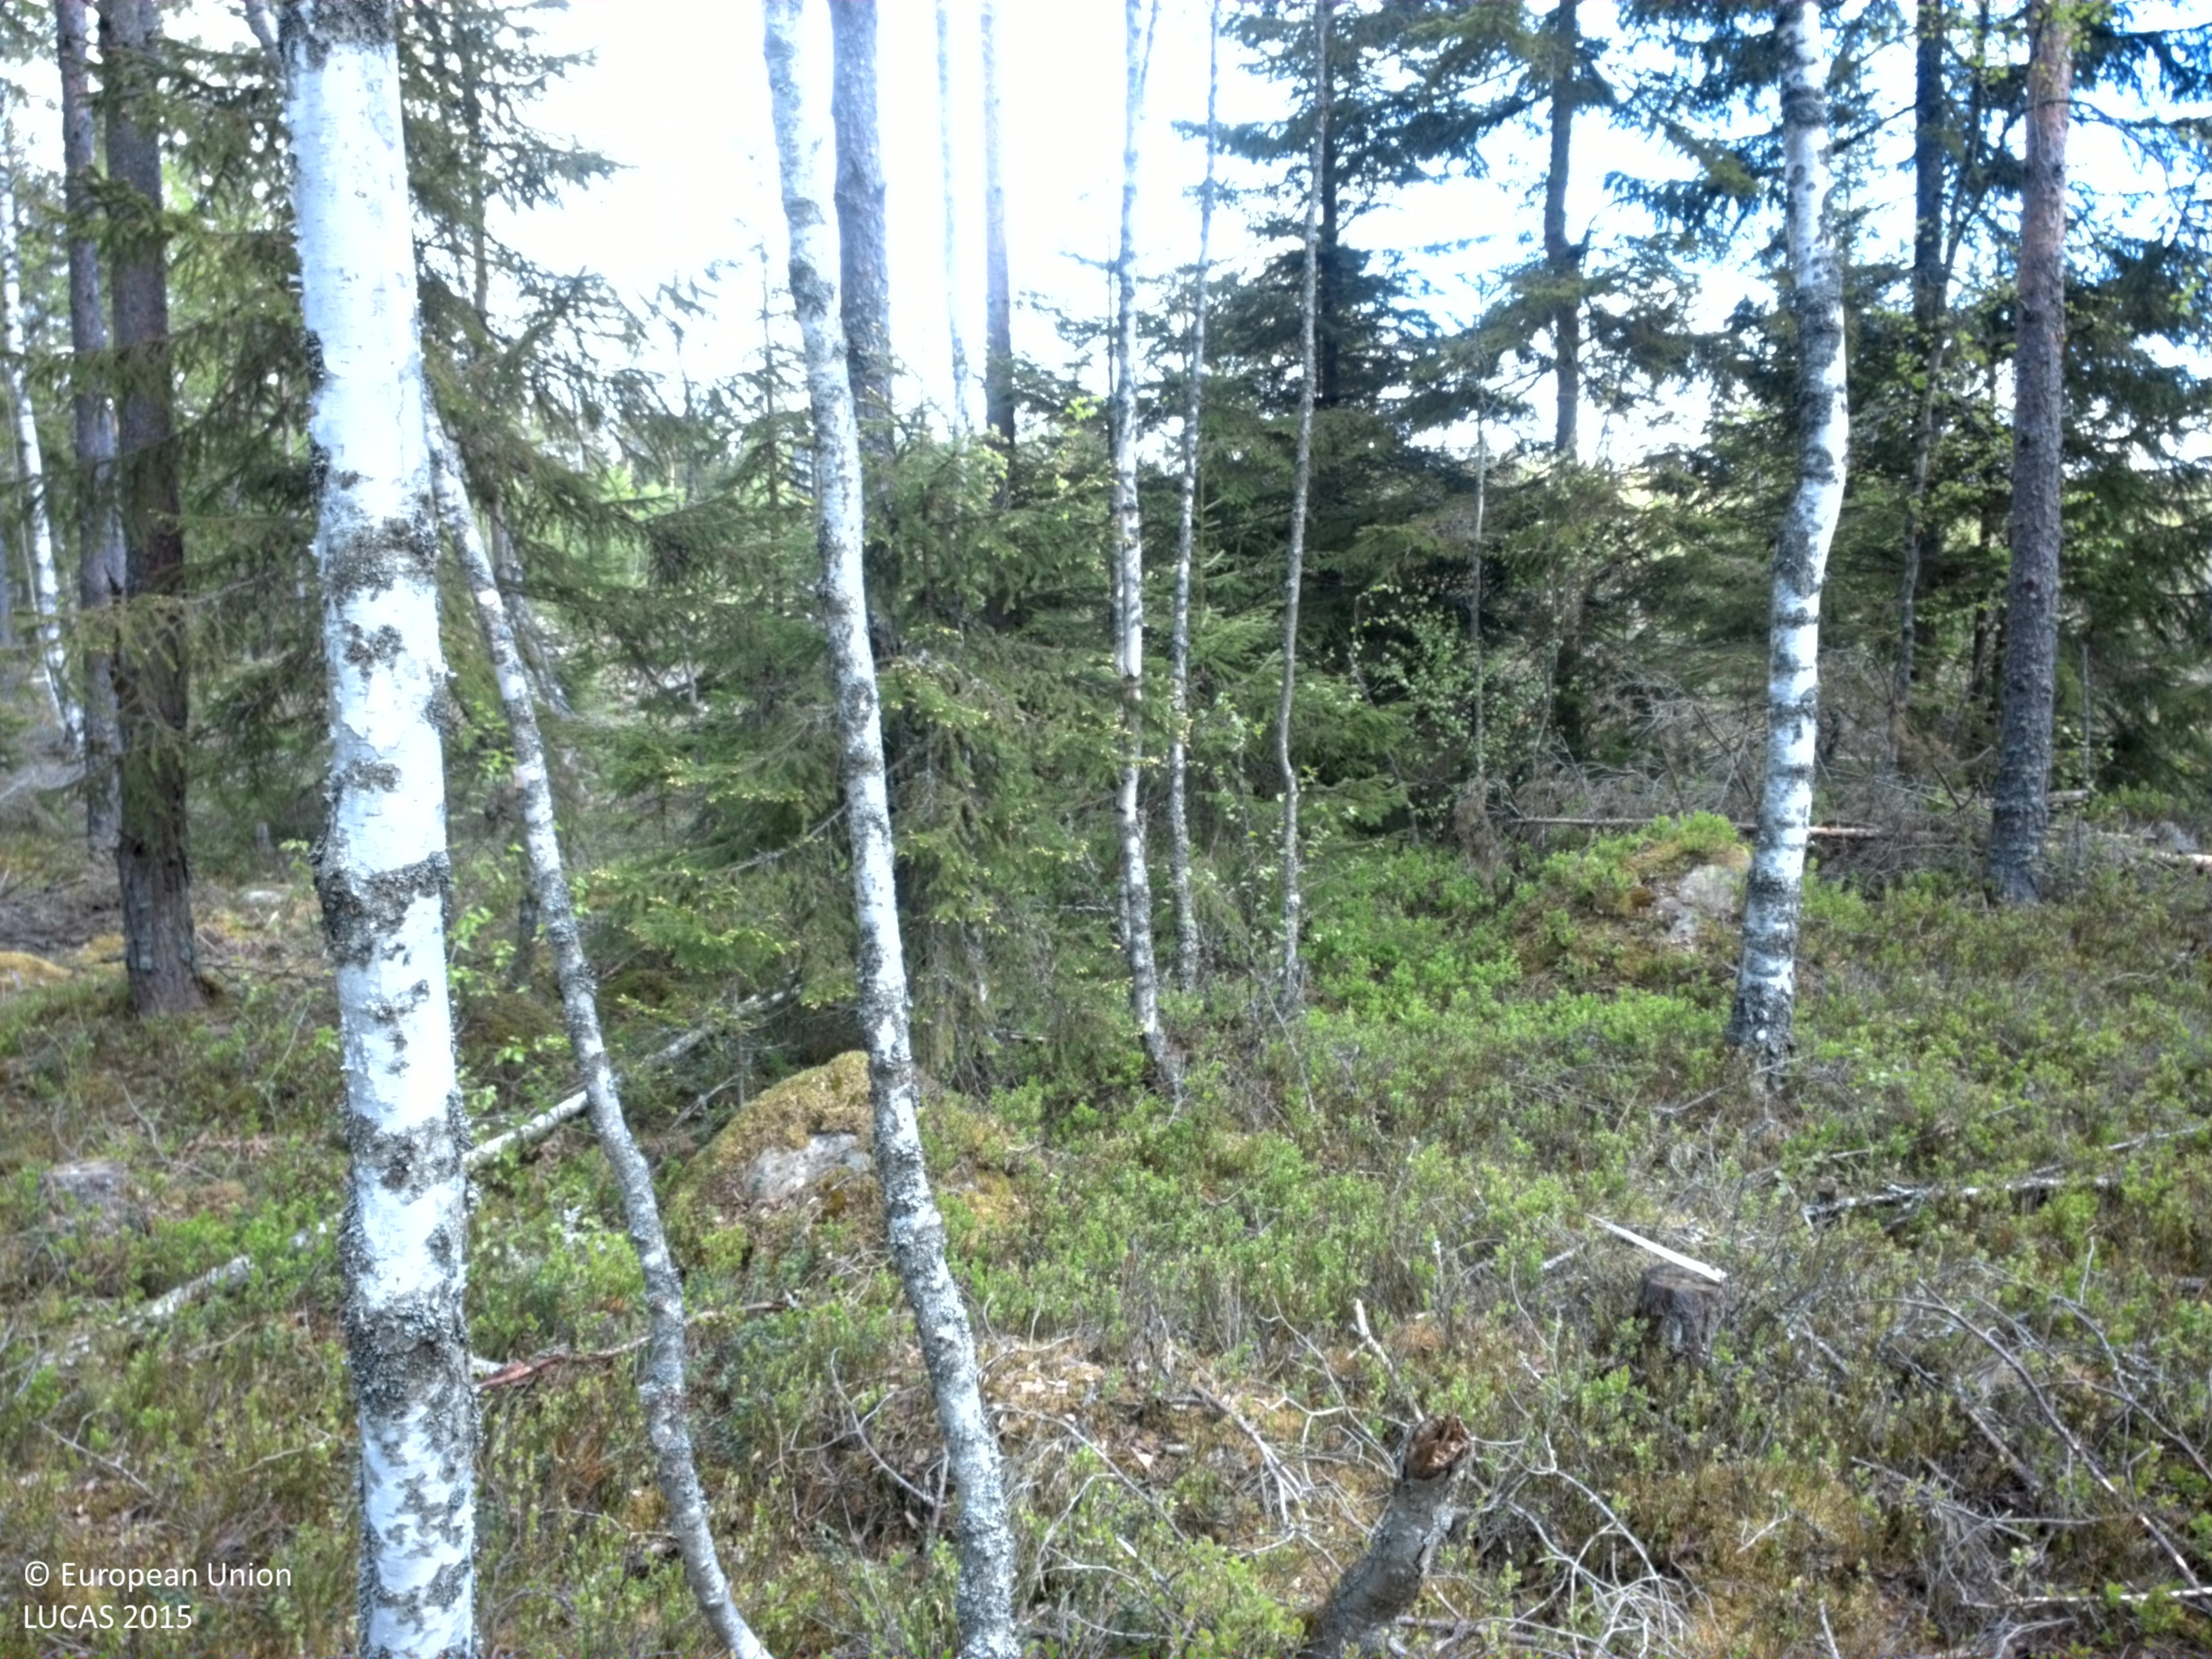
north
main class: Woodland
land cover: Pine dominated coniferous woodland
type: boreal forest
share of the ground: 25 - 50 %
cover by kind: shrubs 30 %, lichens and mosses 30 %, coniferous forest trees 25 %, herbaceous plants 10 %, broadleaved forest trees 5 %
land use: Forestry
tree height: > 5 m
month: May
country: SE
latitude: 56.7280
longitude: 15.2771
